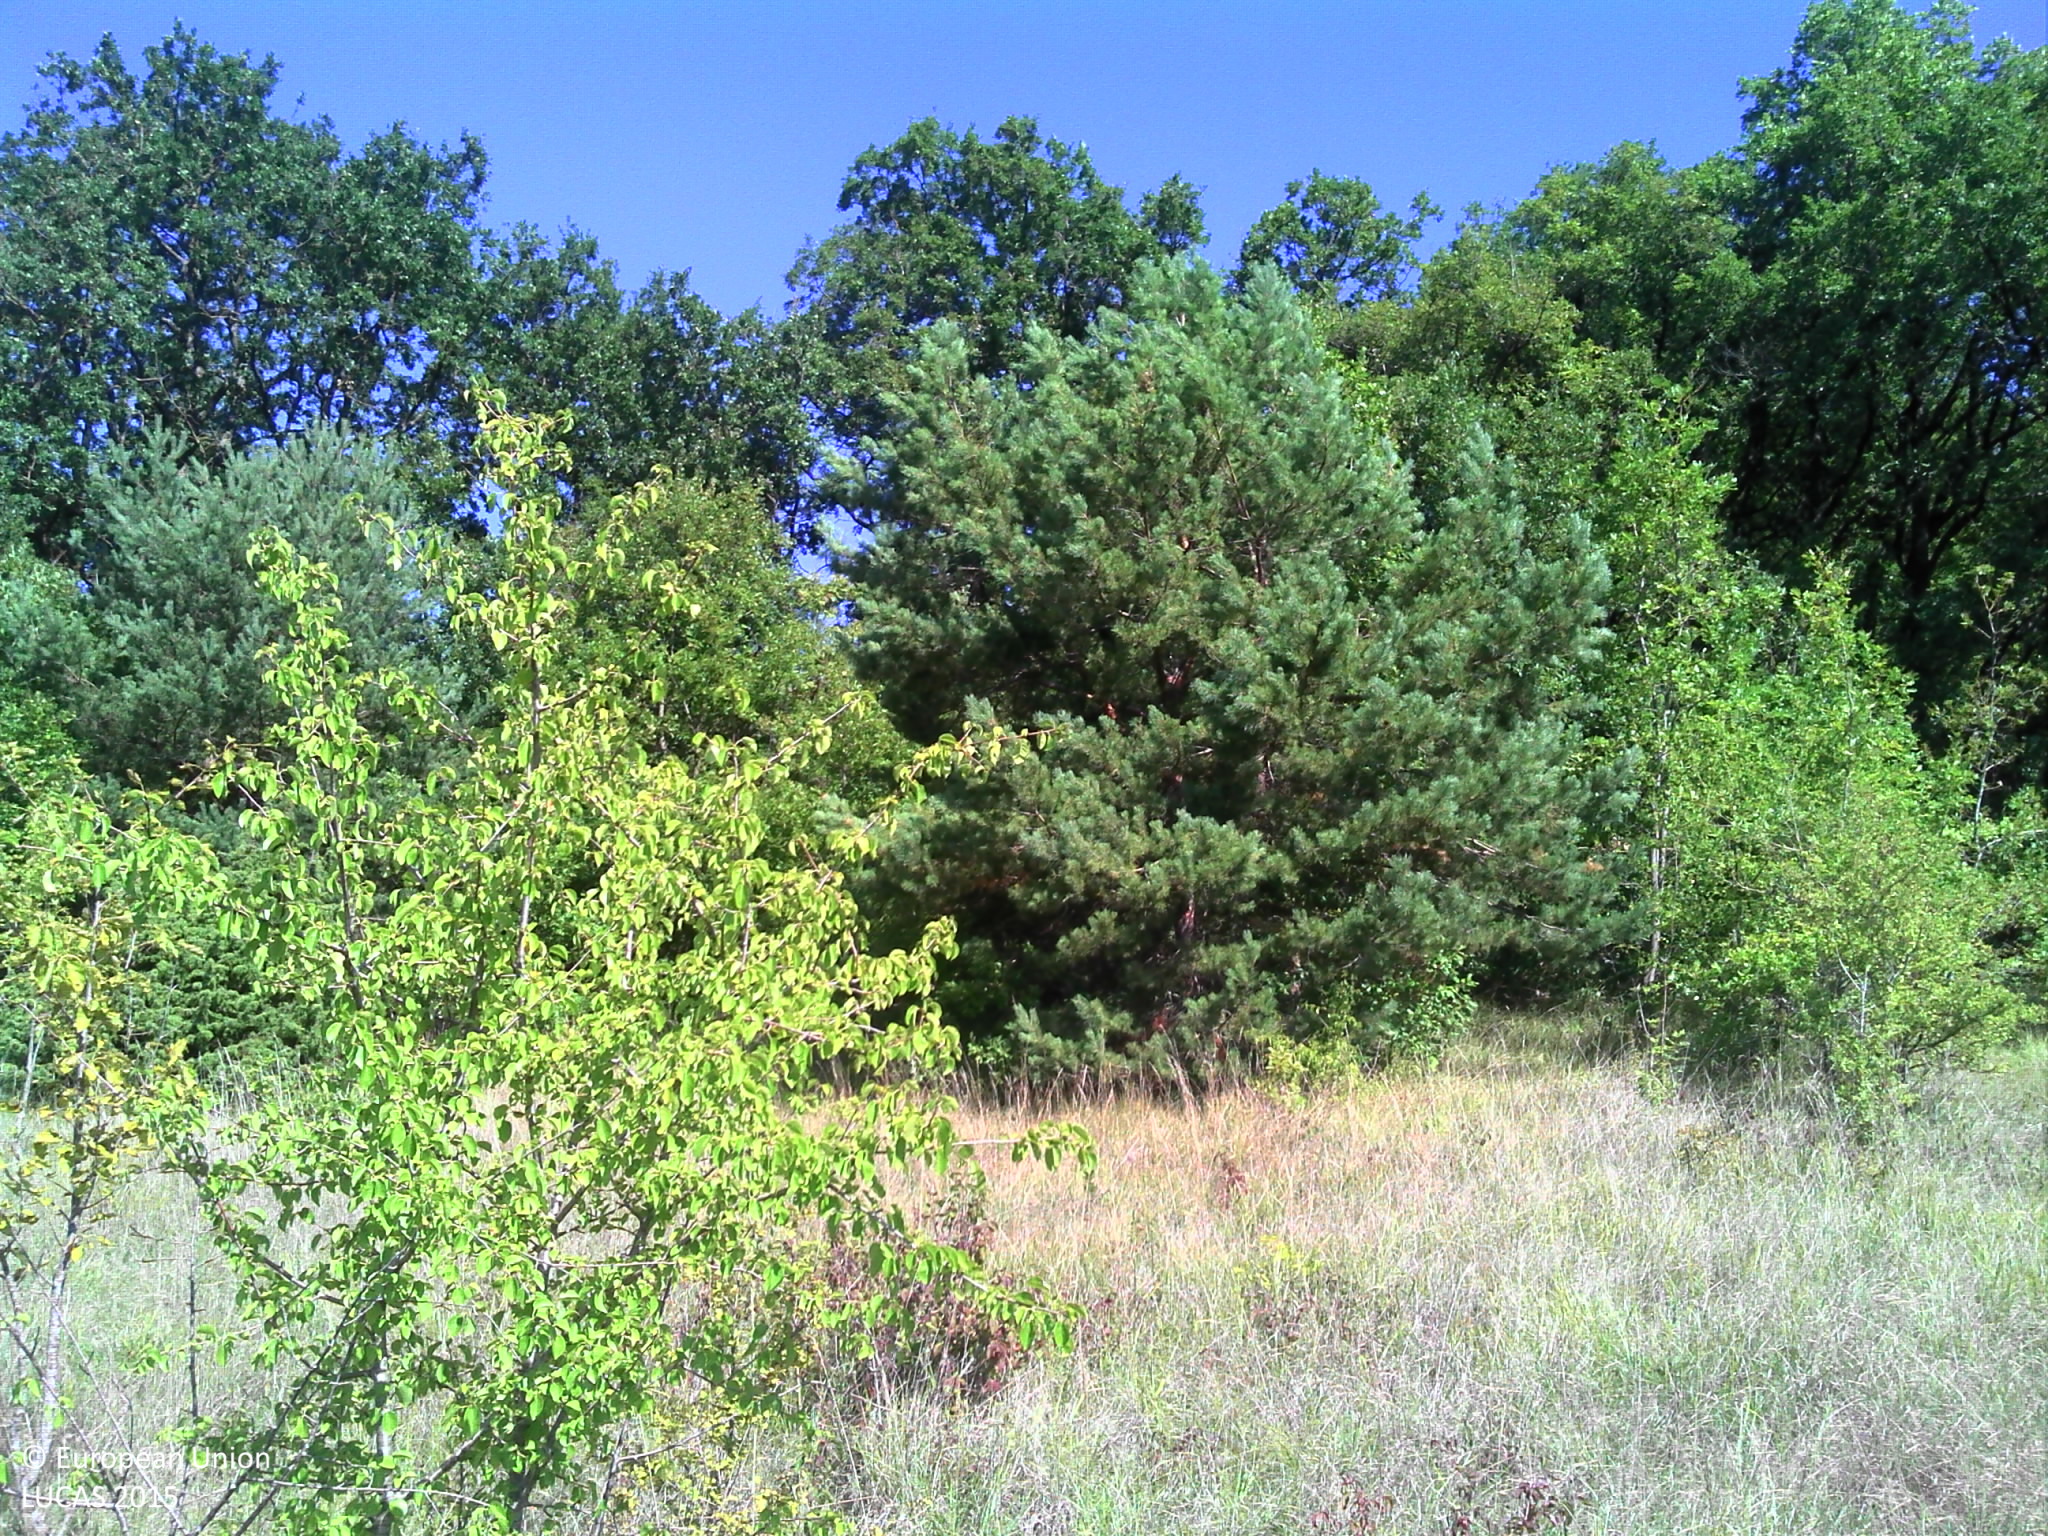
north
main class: Shrubland
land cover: Shrubland with sparse tree cover
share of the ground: > 75 %
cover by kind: herbaceous plants 85 %, shrubs 10 %, broadleaved forest trees 5 %
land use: Semi-natural and natural areas not in use
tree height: < 5 m
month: September
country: FR
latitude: 48.3988
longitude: 3.0090
